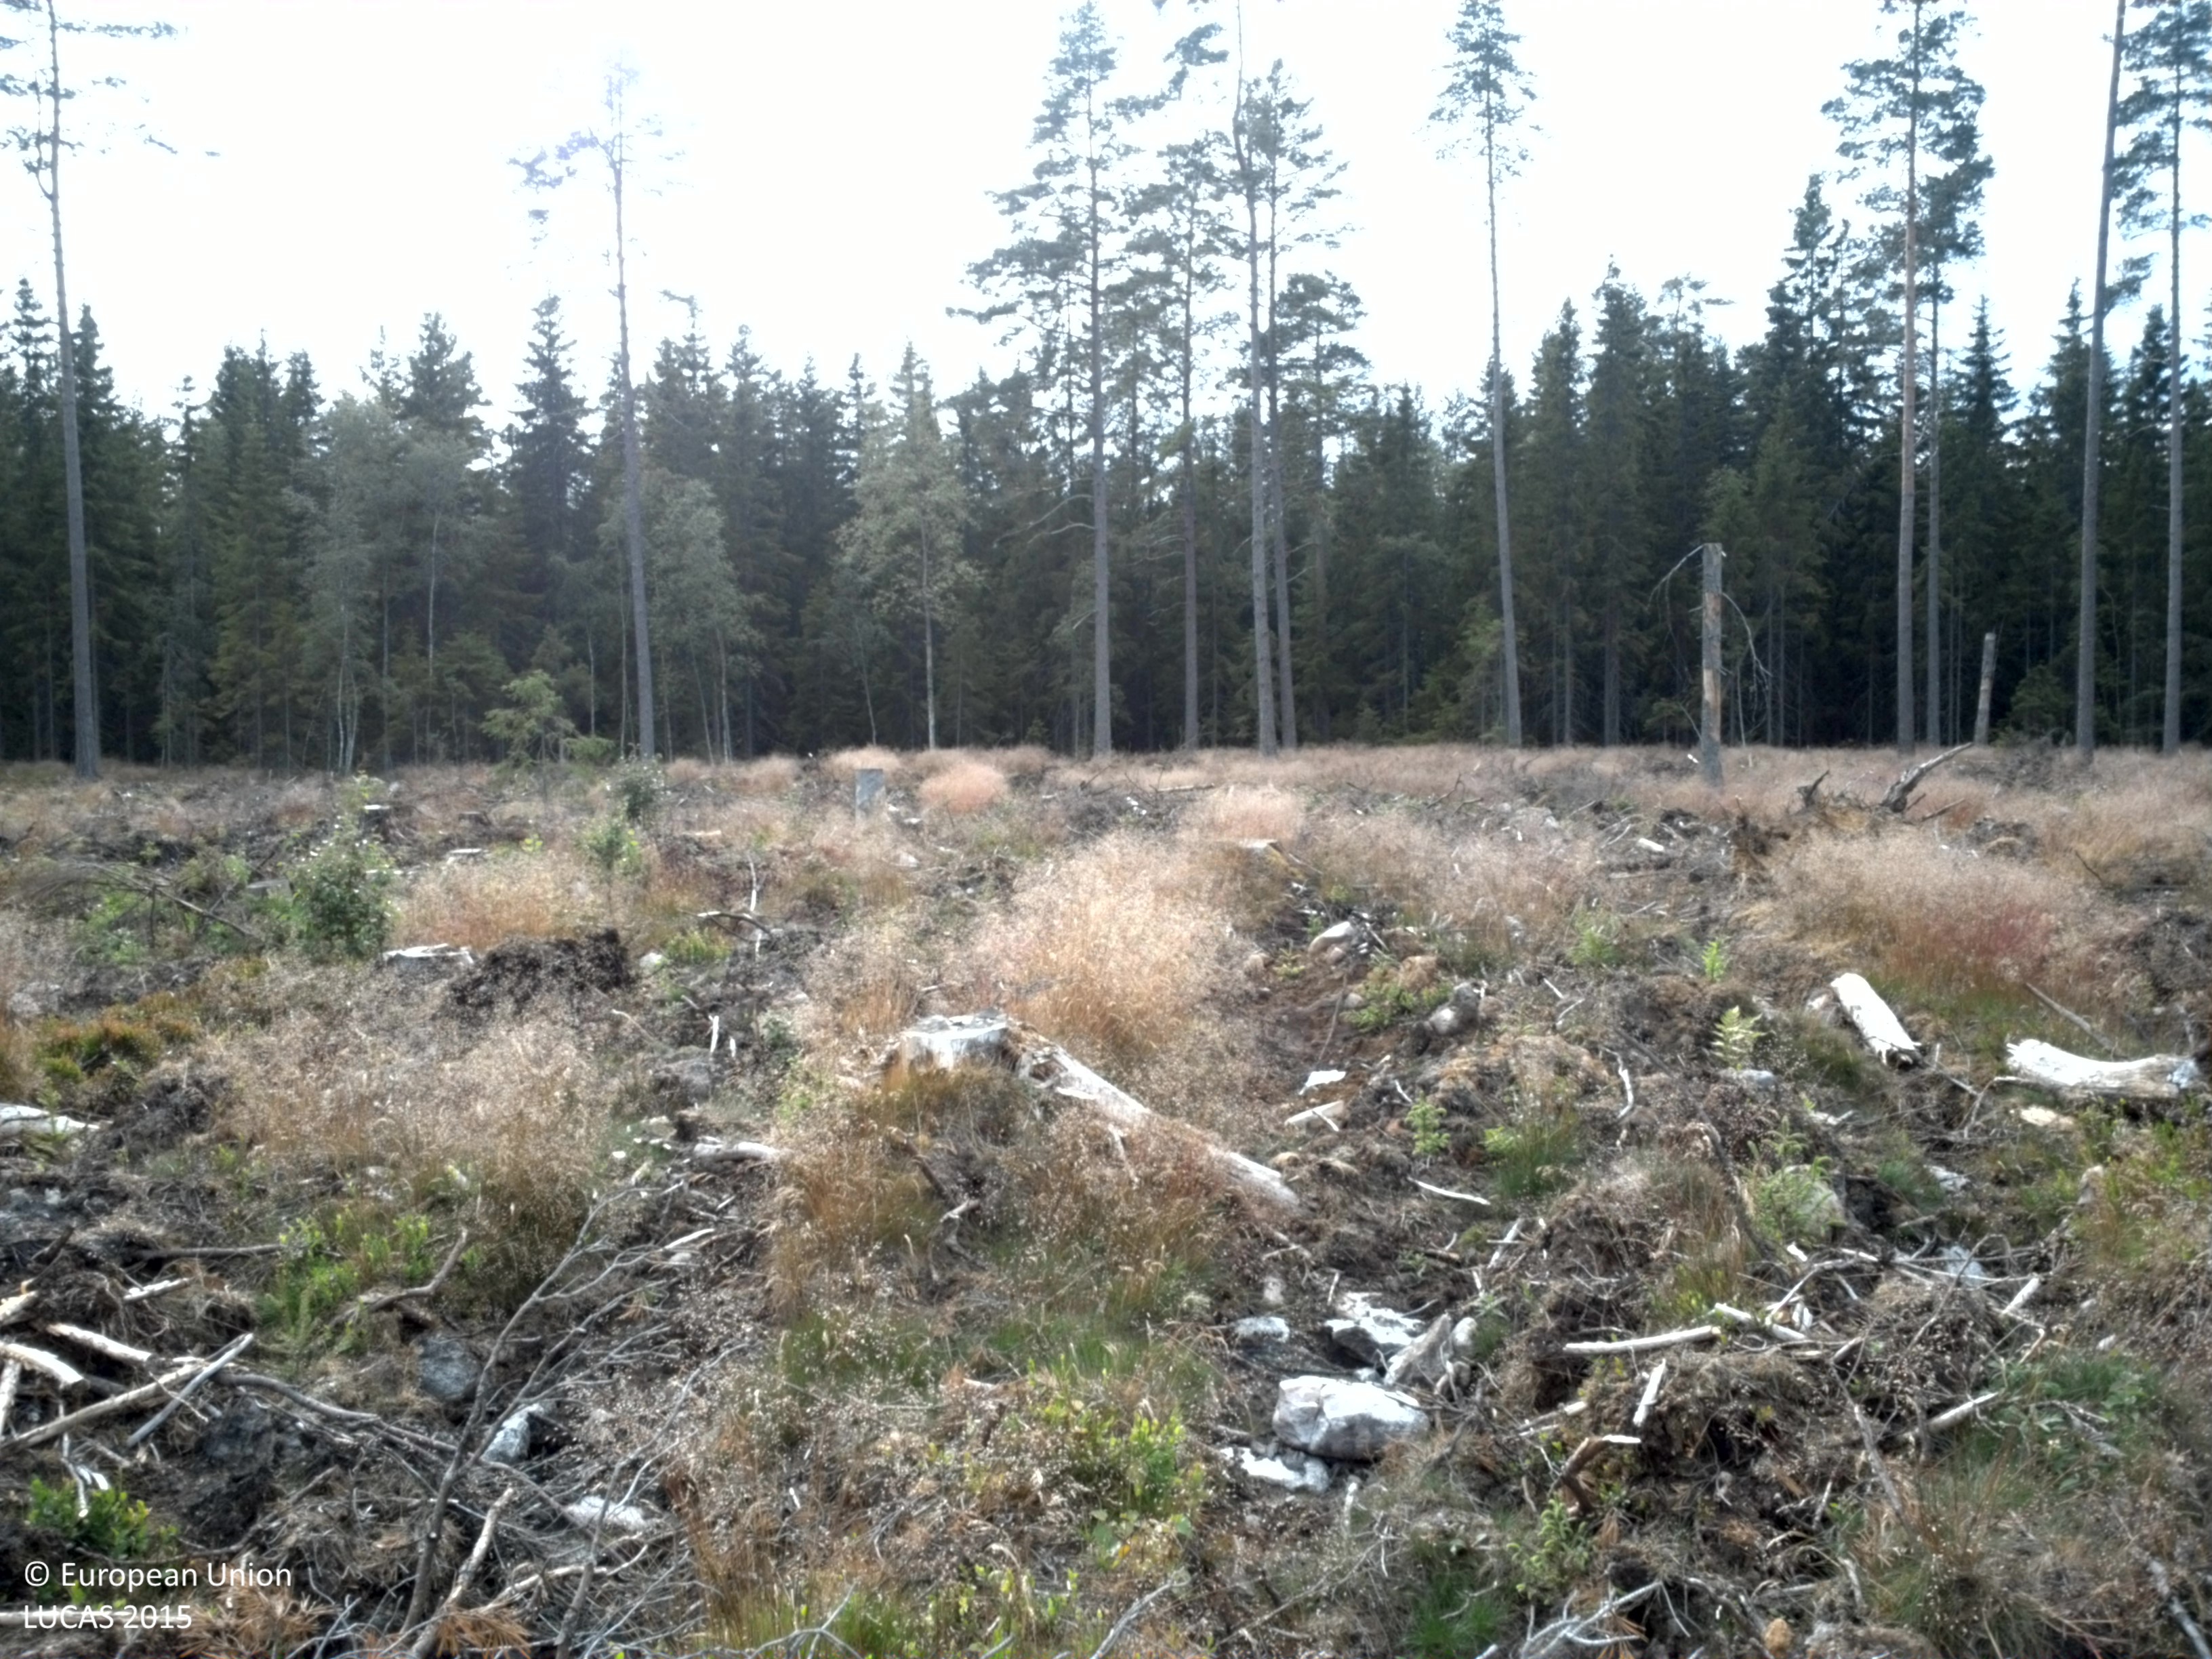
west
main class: Grassland
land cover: Grassland with sparse tree/shrub cover
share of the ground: 50 - 75 %
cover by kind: herbaceous plants 65 %, unconsolidated bare surface 20 %, shrubs 10 %, broadleaved forest trees 5 %
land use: Forestry
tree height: < 5 m
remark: Clear cut
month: July
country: SE
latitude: 57.6149
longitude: 14.6995
